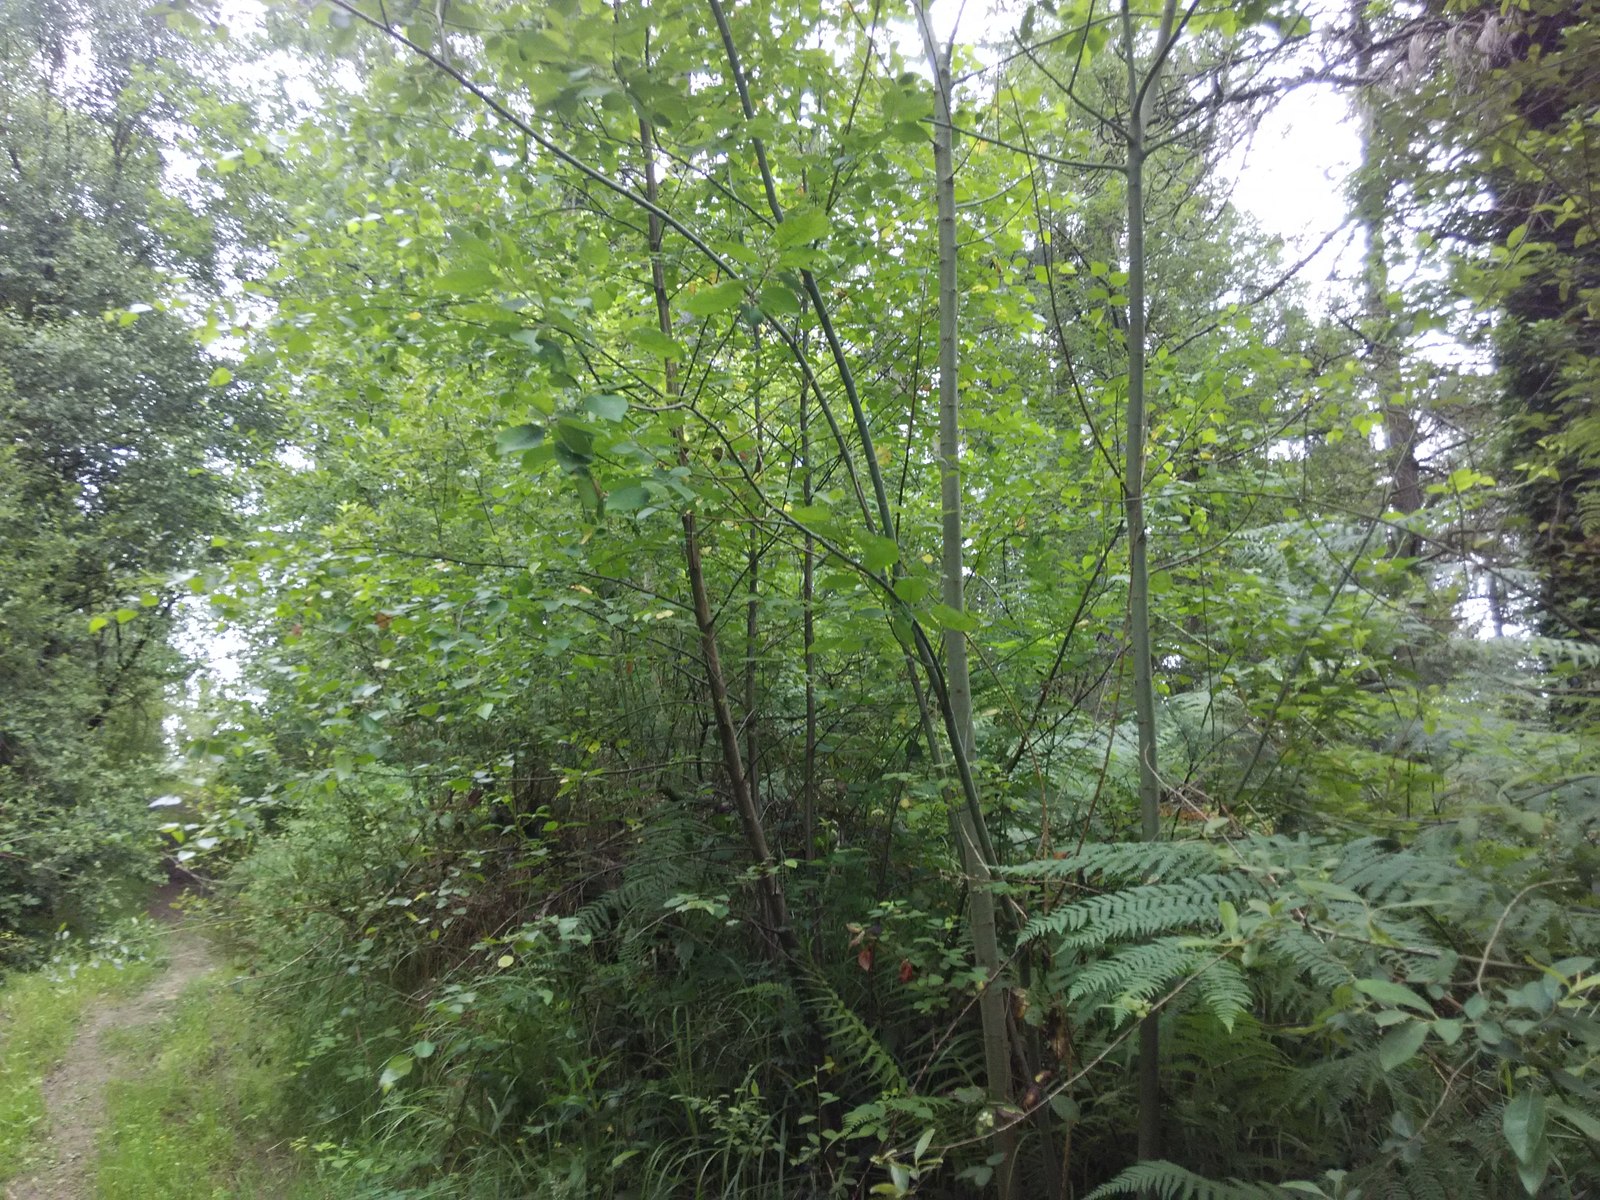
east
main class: Woodland
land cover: Pine dominated coniferous woodland
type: exotic forest
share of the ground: > 75 %
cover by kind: coniferous forest trees 80 %, shrubs 15 %, unconsolidated bare surface 5 %
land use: Forestry
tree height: > 5 m
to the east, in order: Pine dominated coniferous woodland; Shrubland with sparse tree cover; Tracks; Pine dominated coniferous woodland
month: July
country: ES
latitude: 43.1023
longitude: -2.4735
